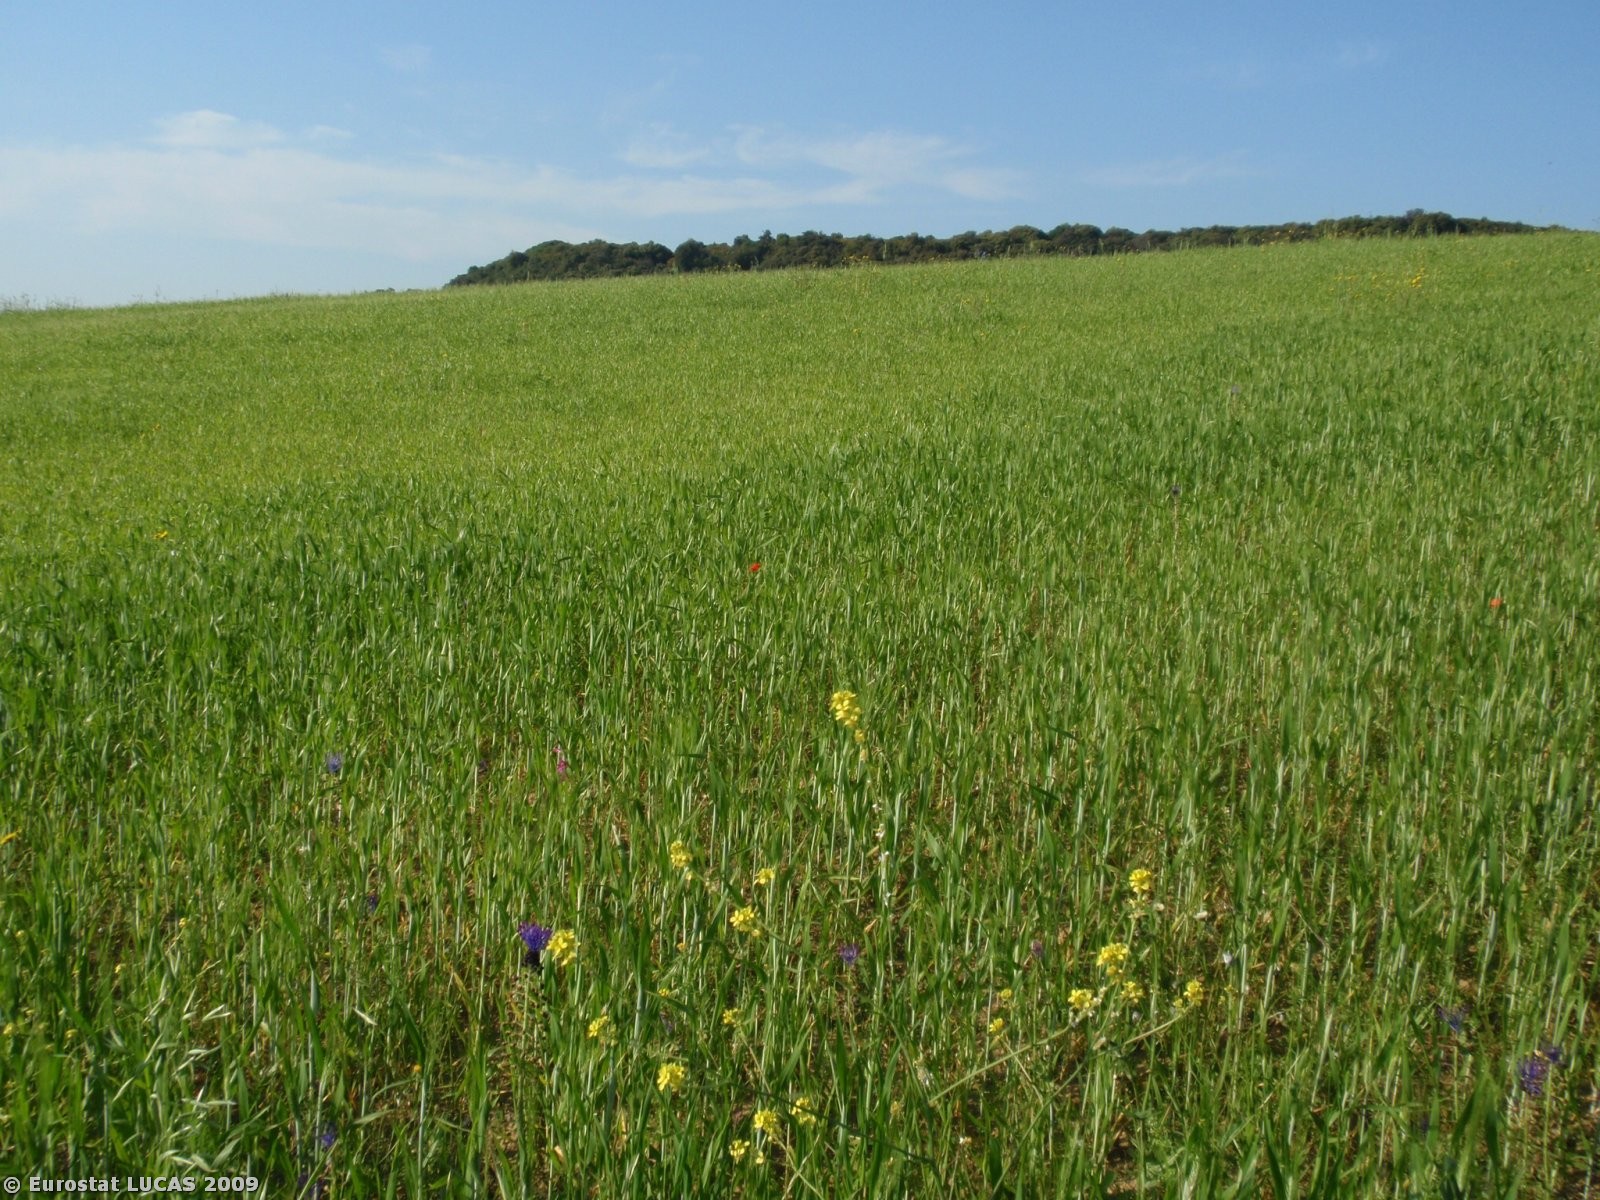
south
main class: Shrubland
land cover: Shrubland without tree cover
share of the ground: > 75 %
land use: Unused
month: May
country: IT
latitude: 40.4825
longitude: 16.5702
